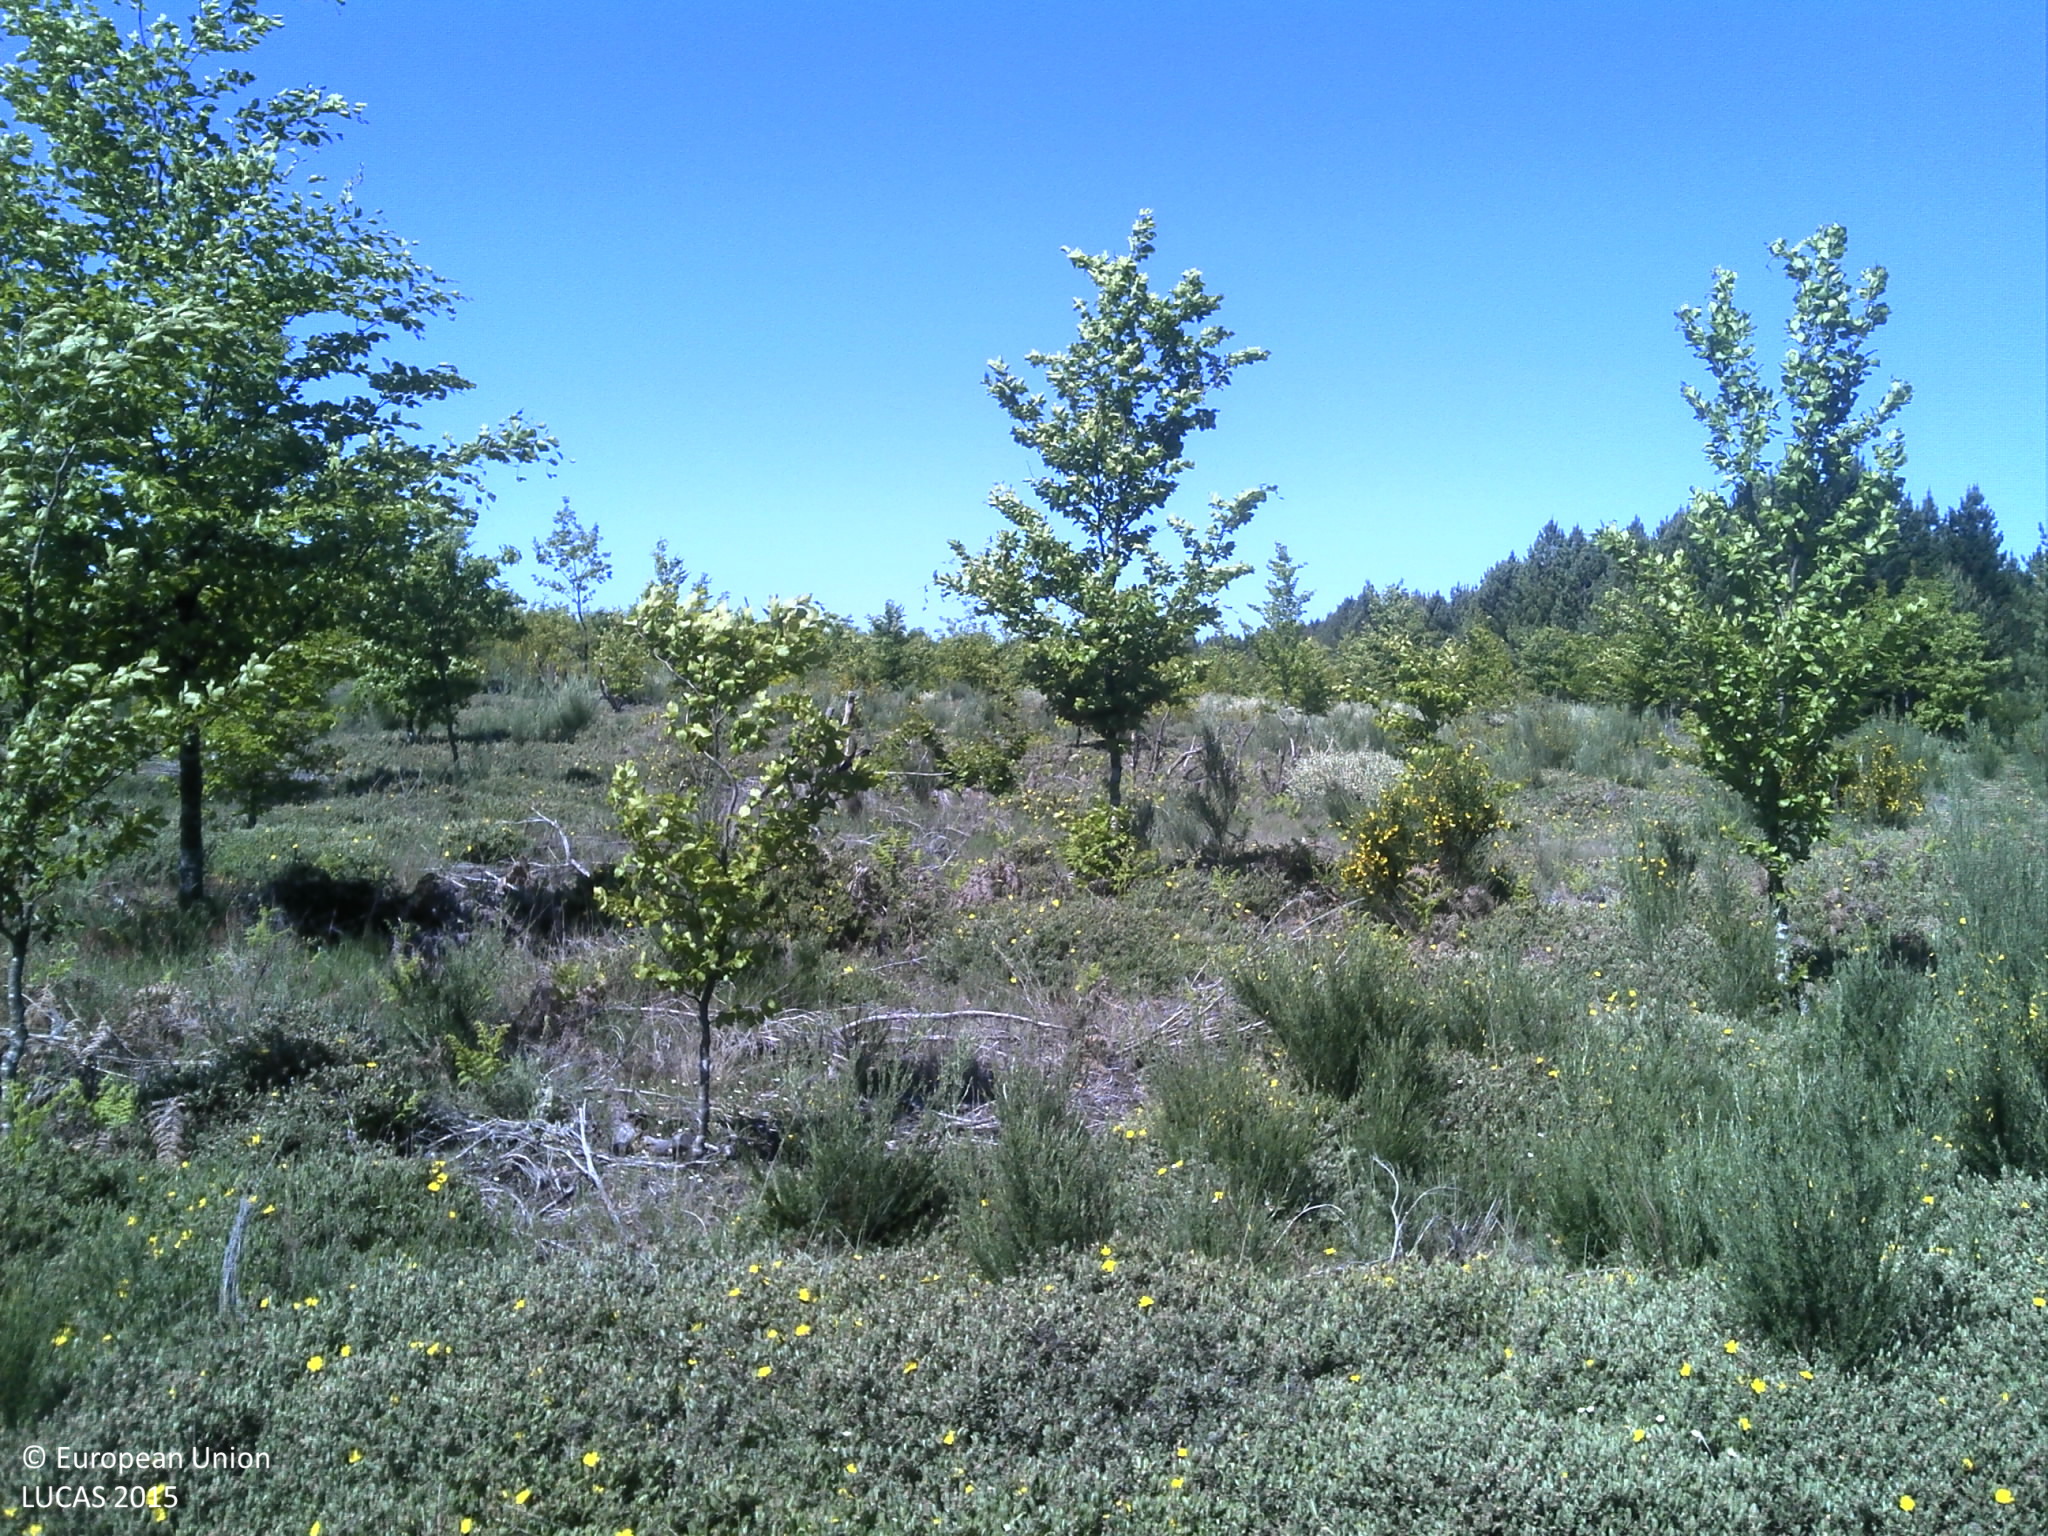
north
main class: Woodland
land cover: Broadleaved woodland
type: mesophytic deciduous forest
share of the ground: 25 - 50 %
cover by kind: broadleaved forest trees 45 %, shrubs 25 %, herbaceous plants 25 %
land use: Forestry
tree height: > 5 m
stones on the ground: 10 - 25 %
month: May
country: PT
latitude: 40.5212
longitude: -7.4252
